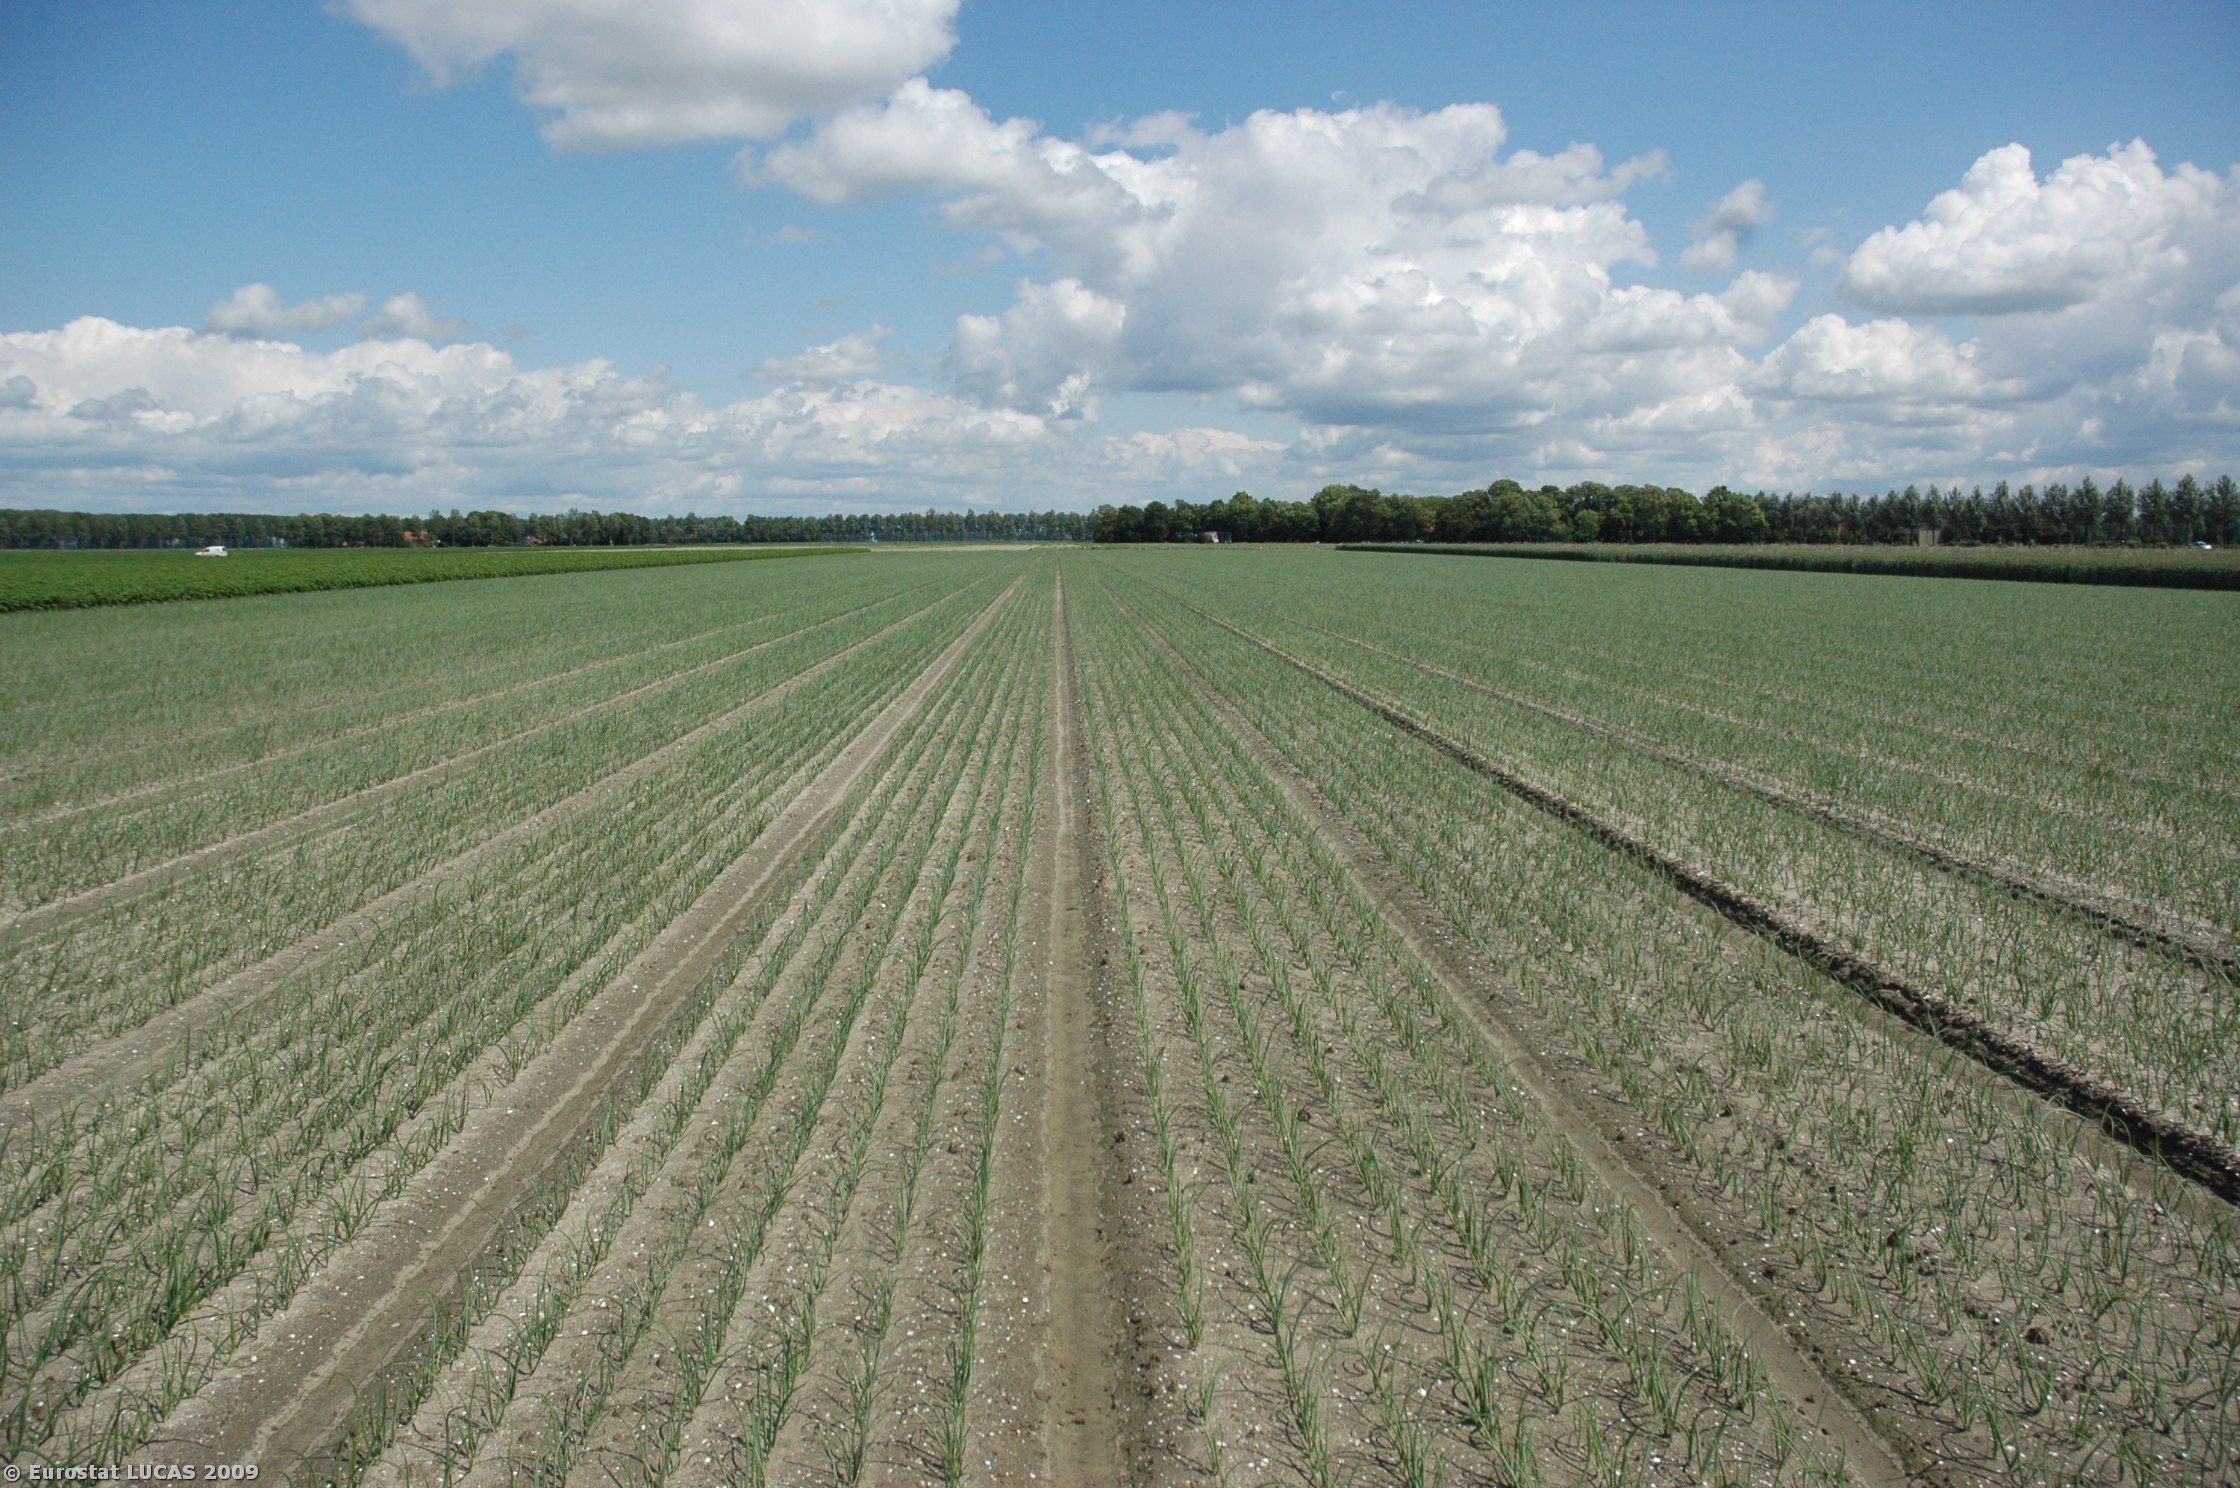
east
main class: Cropland
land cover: Other fresh vegetables
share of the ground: > 75 %
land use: Agriculture (excluding fallow land and kitchen gardens)
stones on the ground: < 10 %
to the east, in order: Other fresh vegetables; Tracks; Grassland without tree/shrub cover
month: June
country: NL
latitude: 52.7112
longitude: 5.6322
